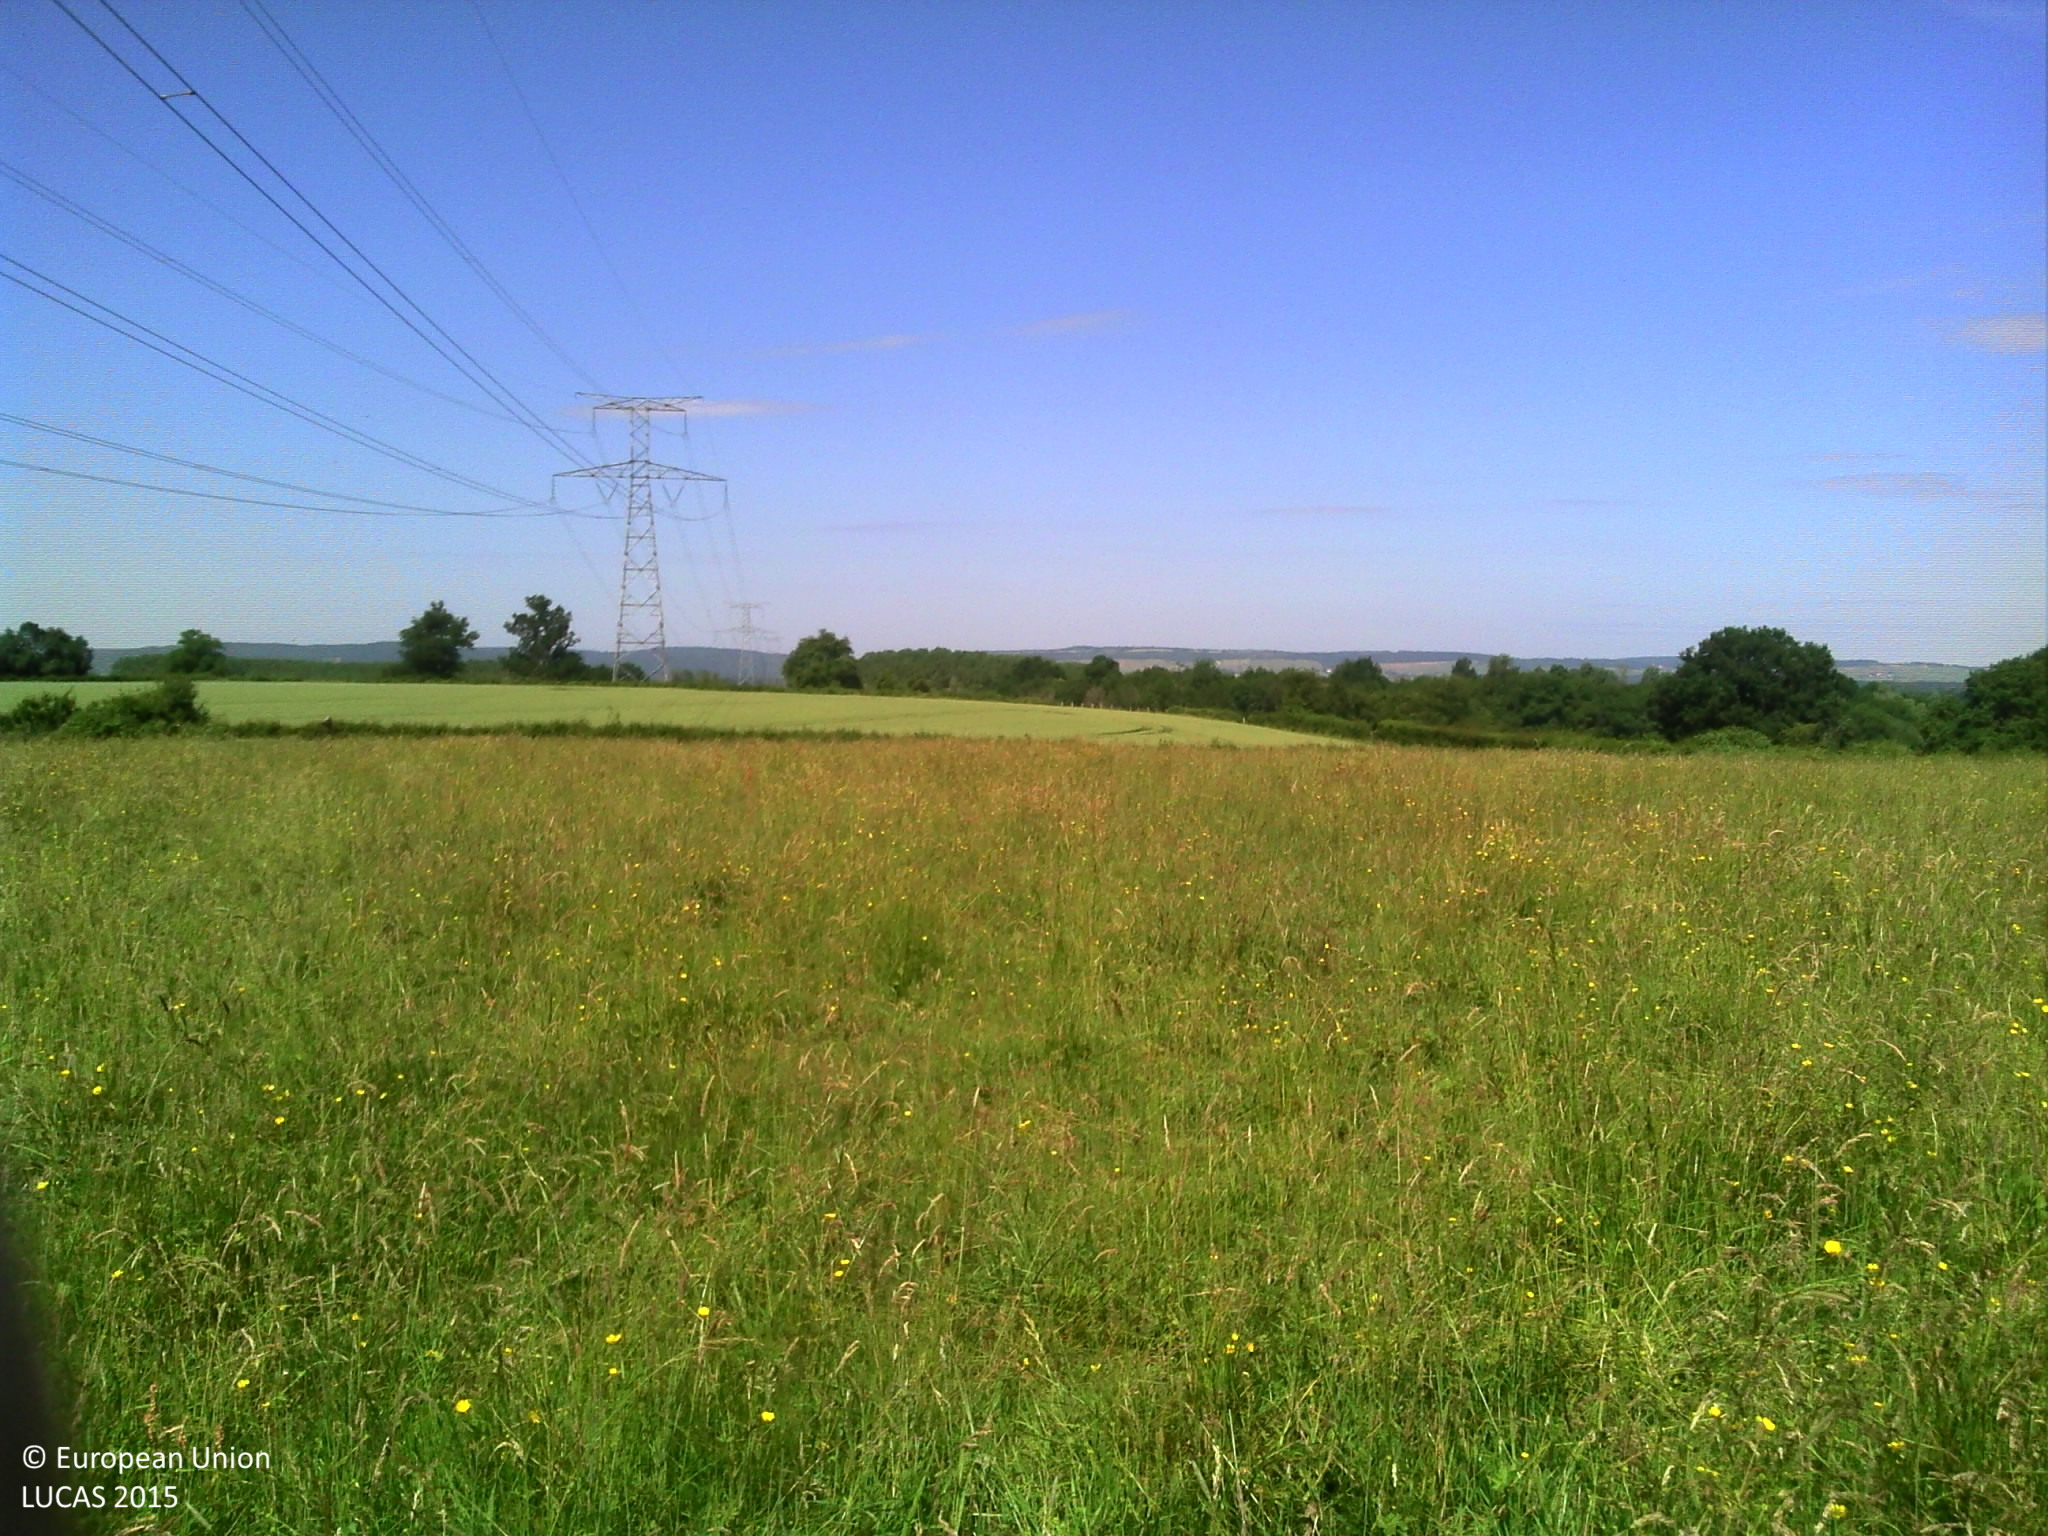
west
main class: Grassland
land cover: Grassland without tree/shrub cover
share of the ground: > 75 %
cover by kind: herbaceous plants 100 %
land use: Agriculture (excluding fallow land and kitchen gardens)
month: June
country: FR
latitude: 46.6393
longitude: 4.7891
